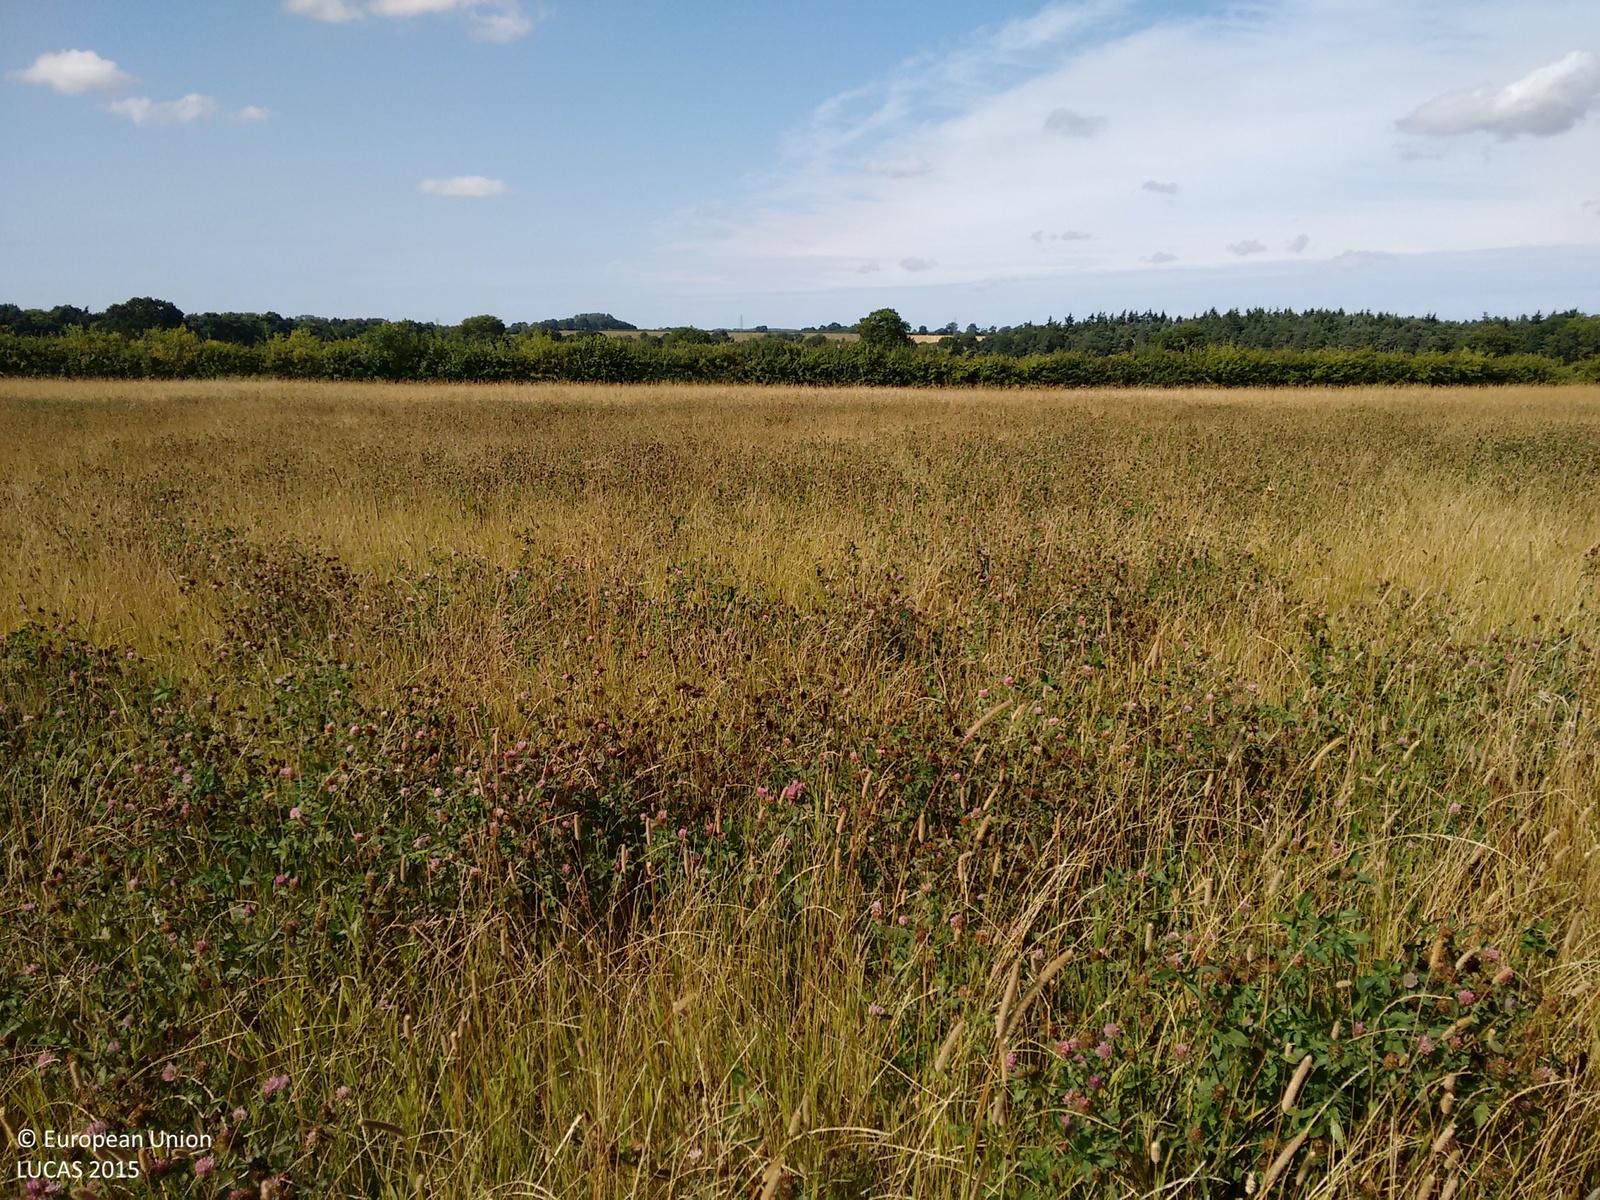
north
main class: Grassland
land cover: Grassland without tree/shrub cover
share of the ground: > 75 %
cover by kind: herbaceous plants 100 %
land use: Agriculture (excluding fallow land and kitchen gardens)
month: August
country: GB
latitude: 52.7417
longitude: 0.7768
